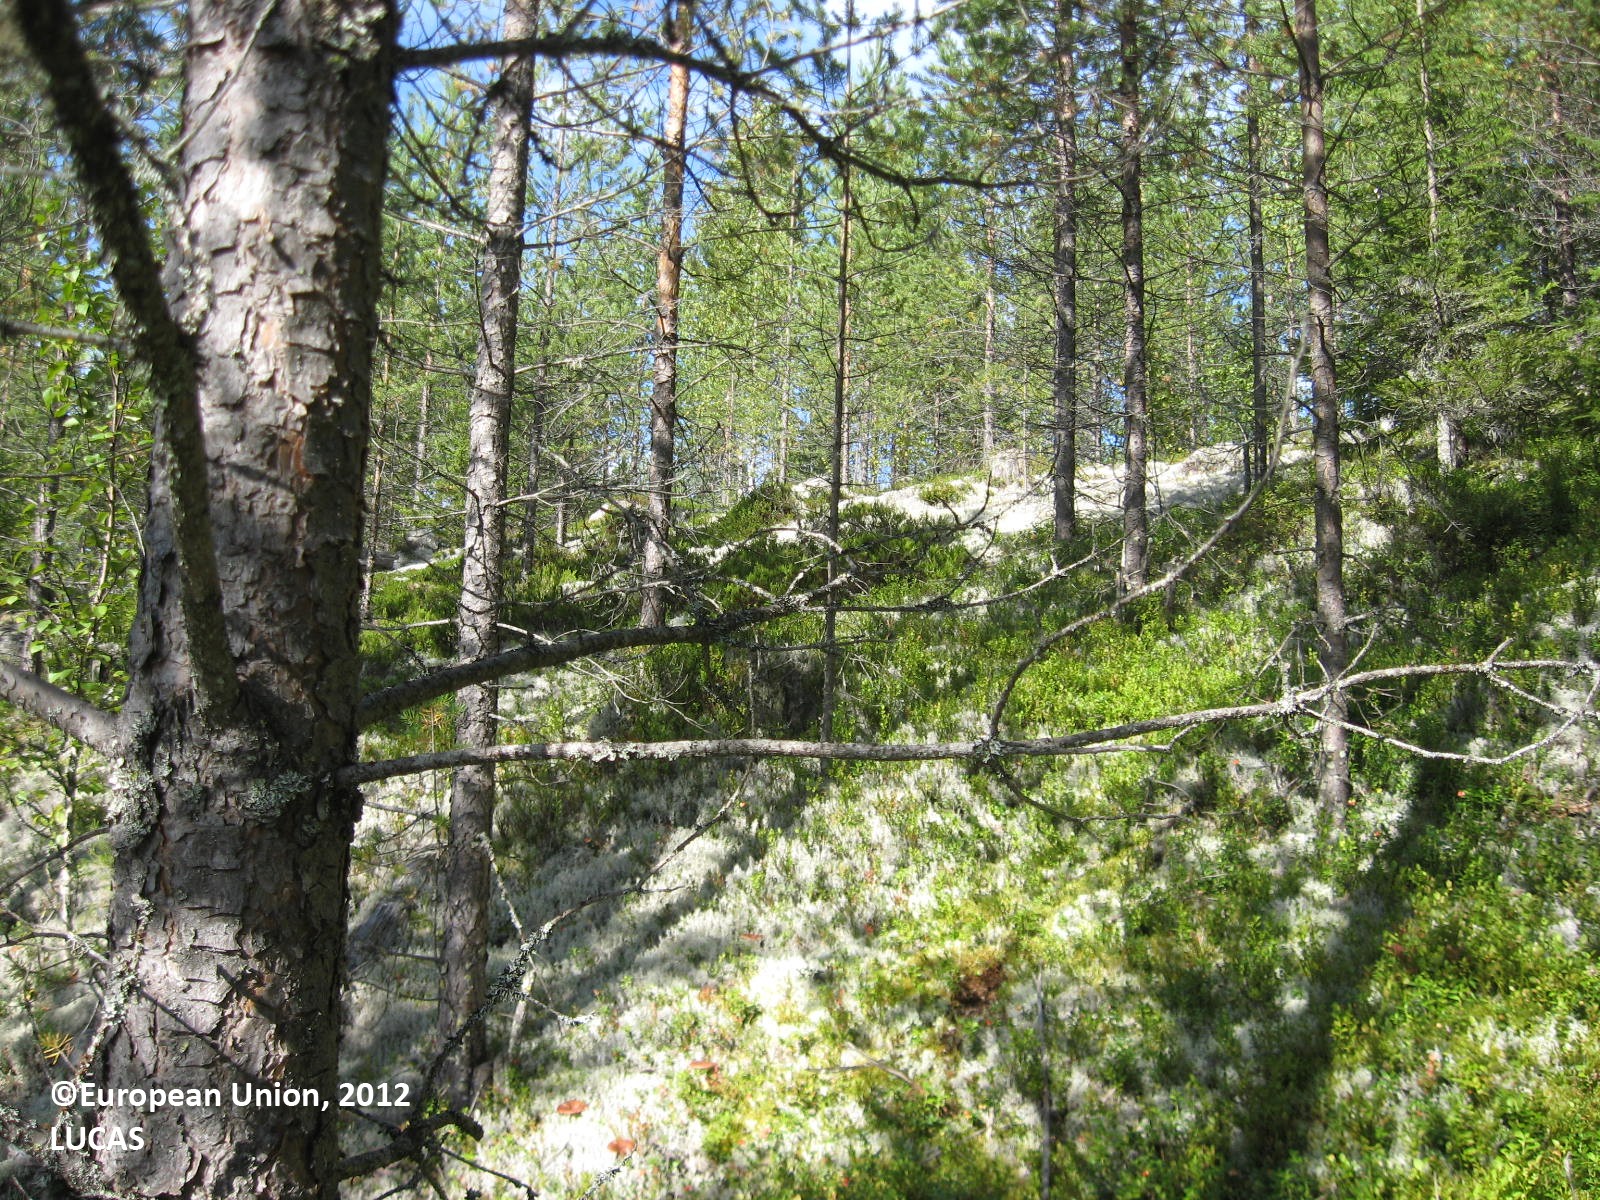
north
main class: Woodland
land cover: Pine dominated coniferous woodland
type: boreal forest
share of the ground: > 75 %
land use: Forestry
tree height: > 5 m
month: August
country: FI
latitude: 63.6798
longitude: 29.7420
